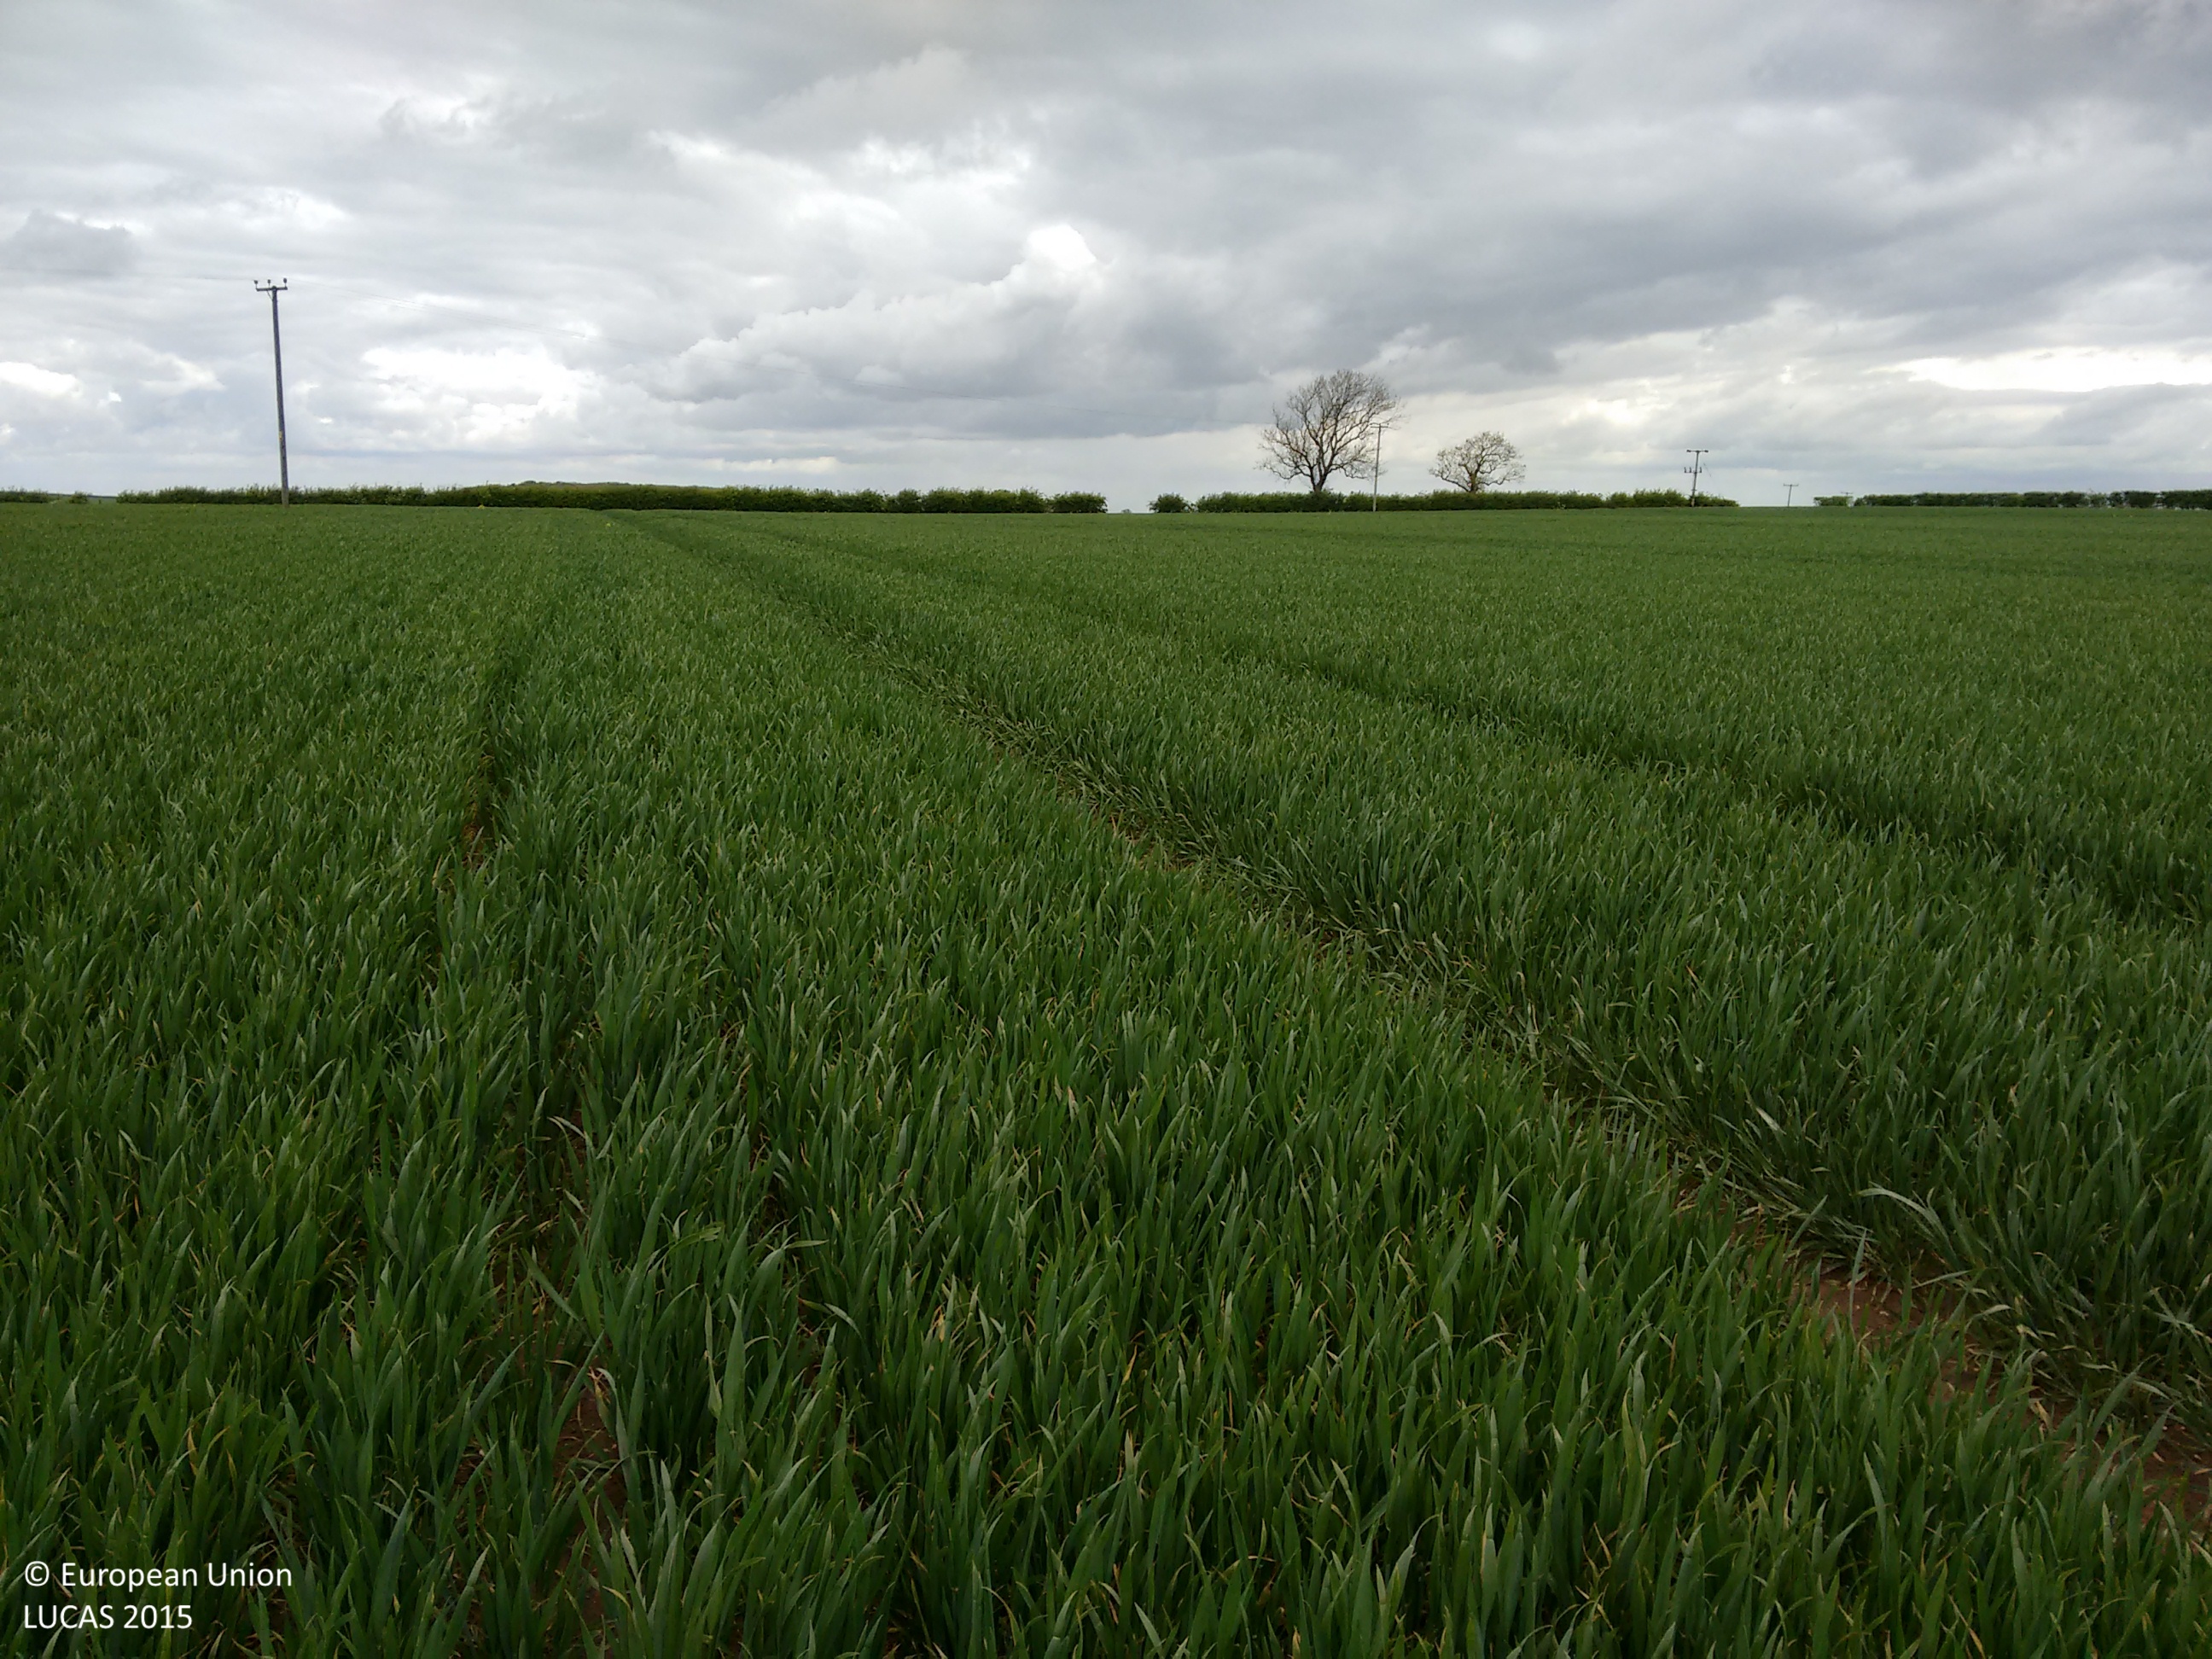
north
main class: Cropland
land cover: Common wheat
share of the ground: > 75 %
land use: Agriculture (excluding fallow land and kitchen gardens)
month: May
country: GB
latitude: 53.5128
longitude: -0.2130
